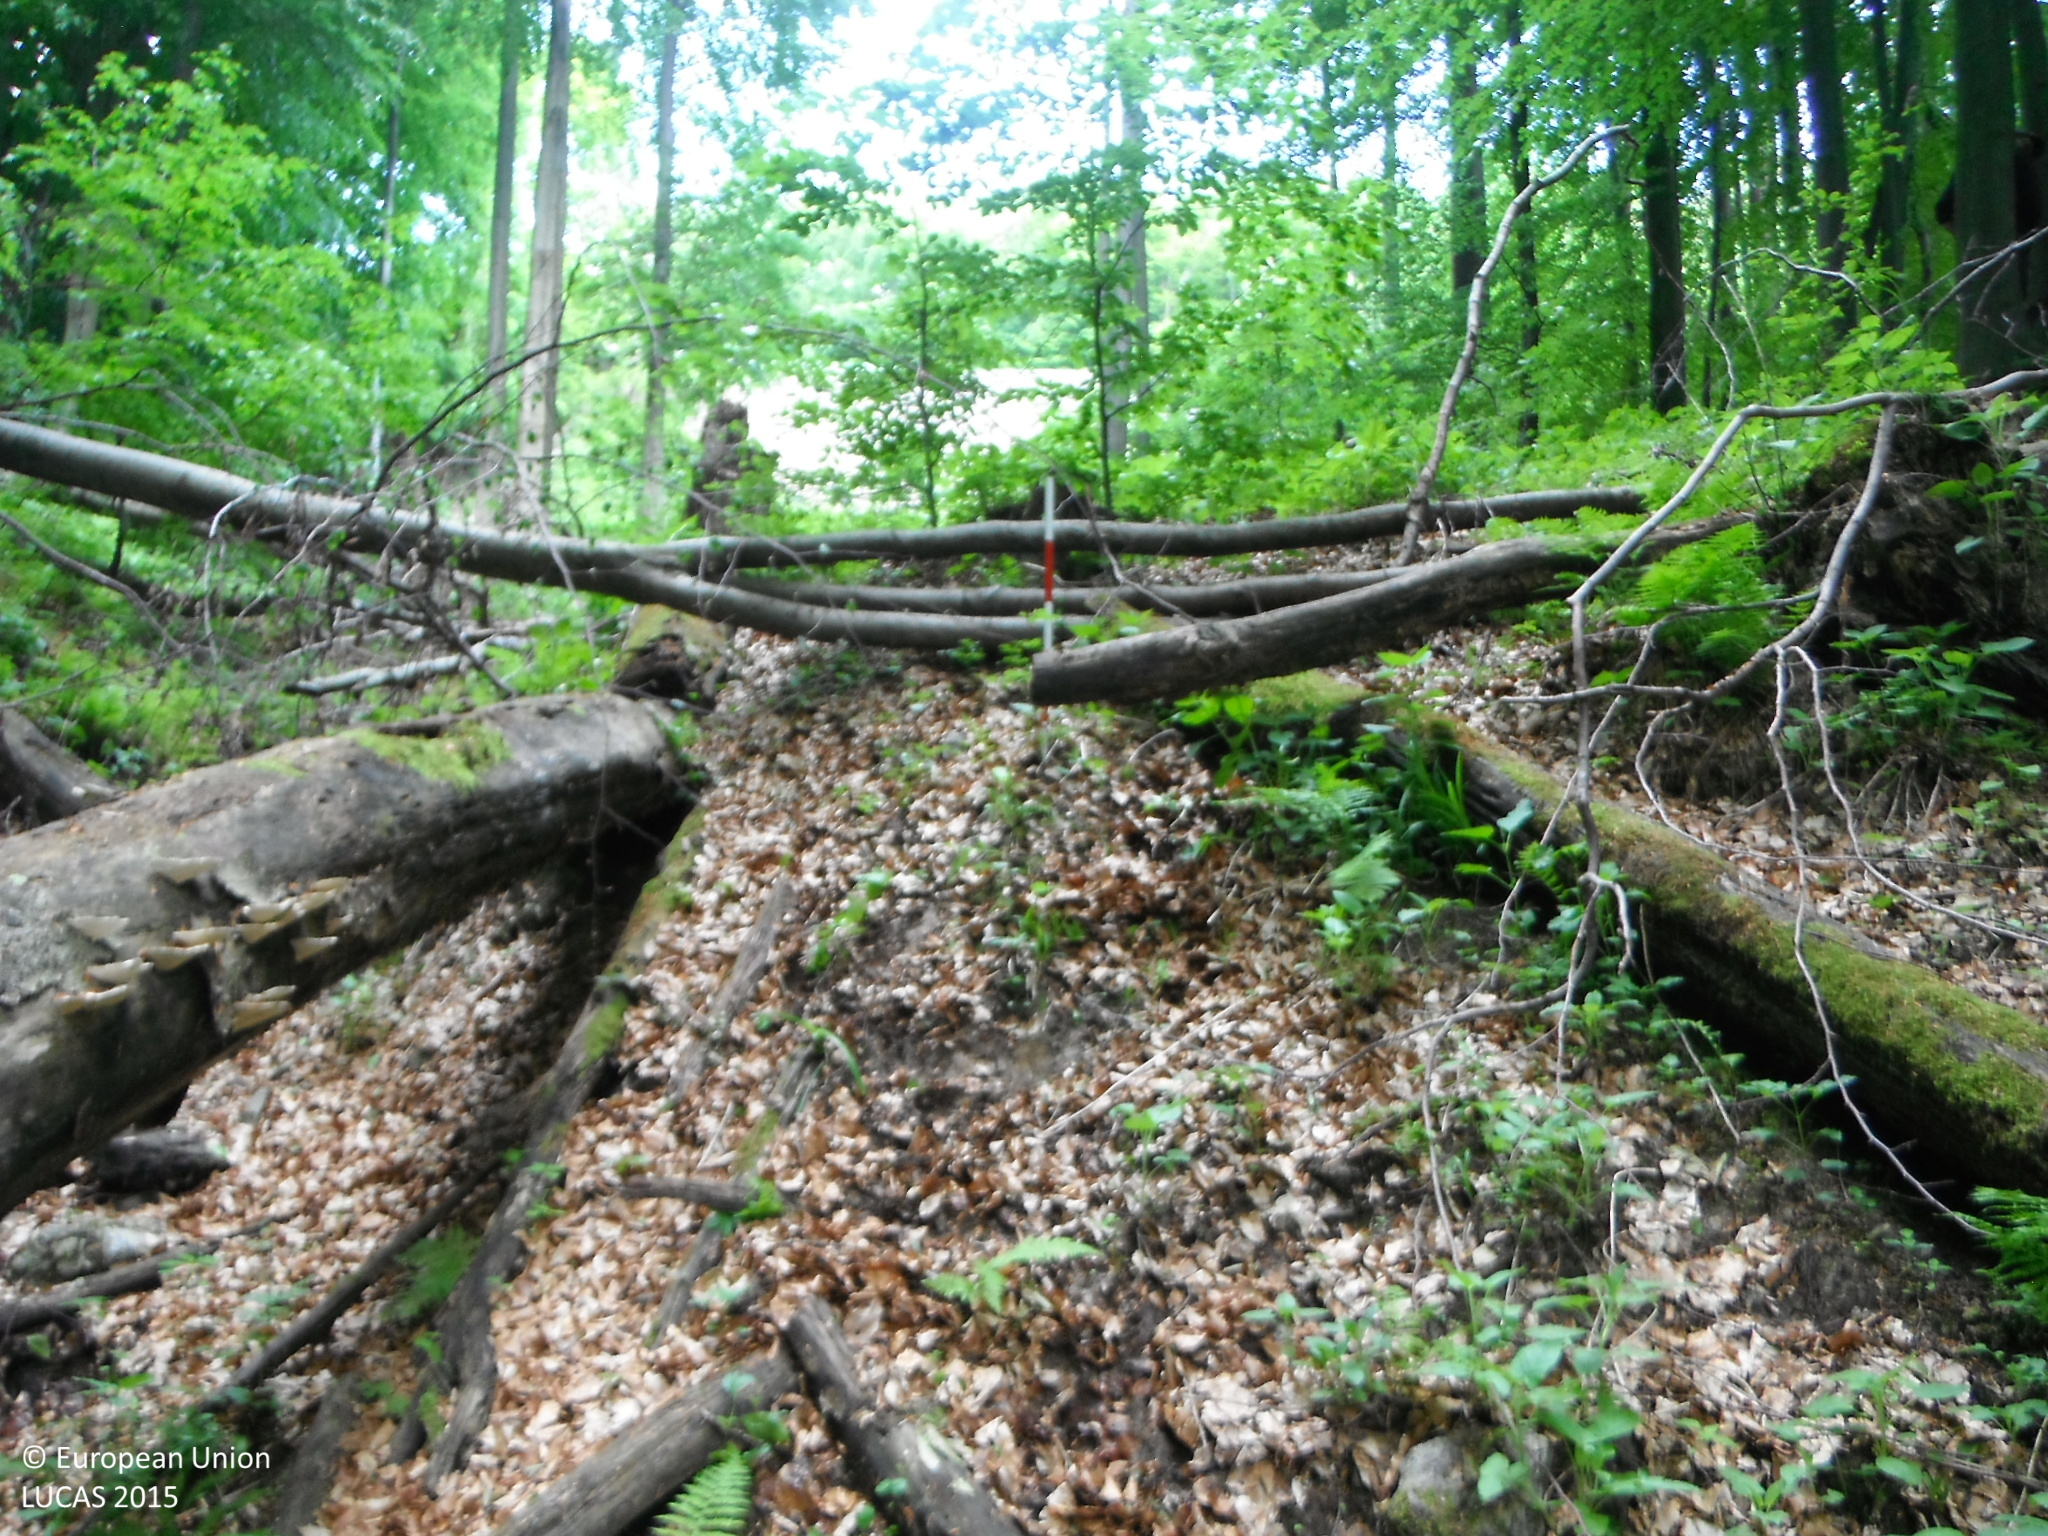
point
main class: Woodland
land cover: Broadleaved woodland
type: beech forest
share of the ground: > 75 %
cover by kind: broadleaved forest trees 50 %, shrubs 20 %, unconsolidated bare surface 20 %, herbaceous plants 10 %
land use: Forestry
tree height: > 5 m
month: May
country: SK
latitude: 48.3492
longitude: 17.2010
